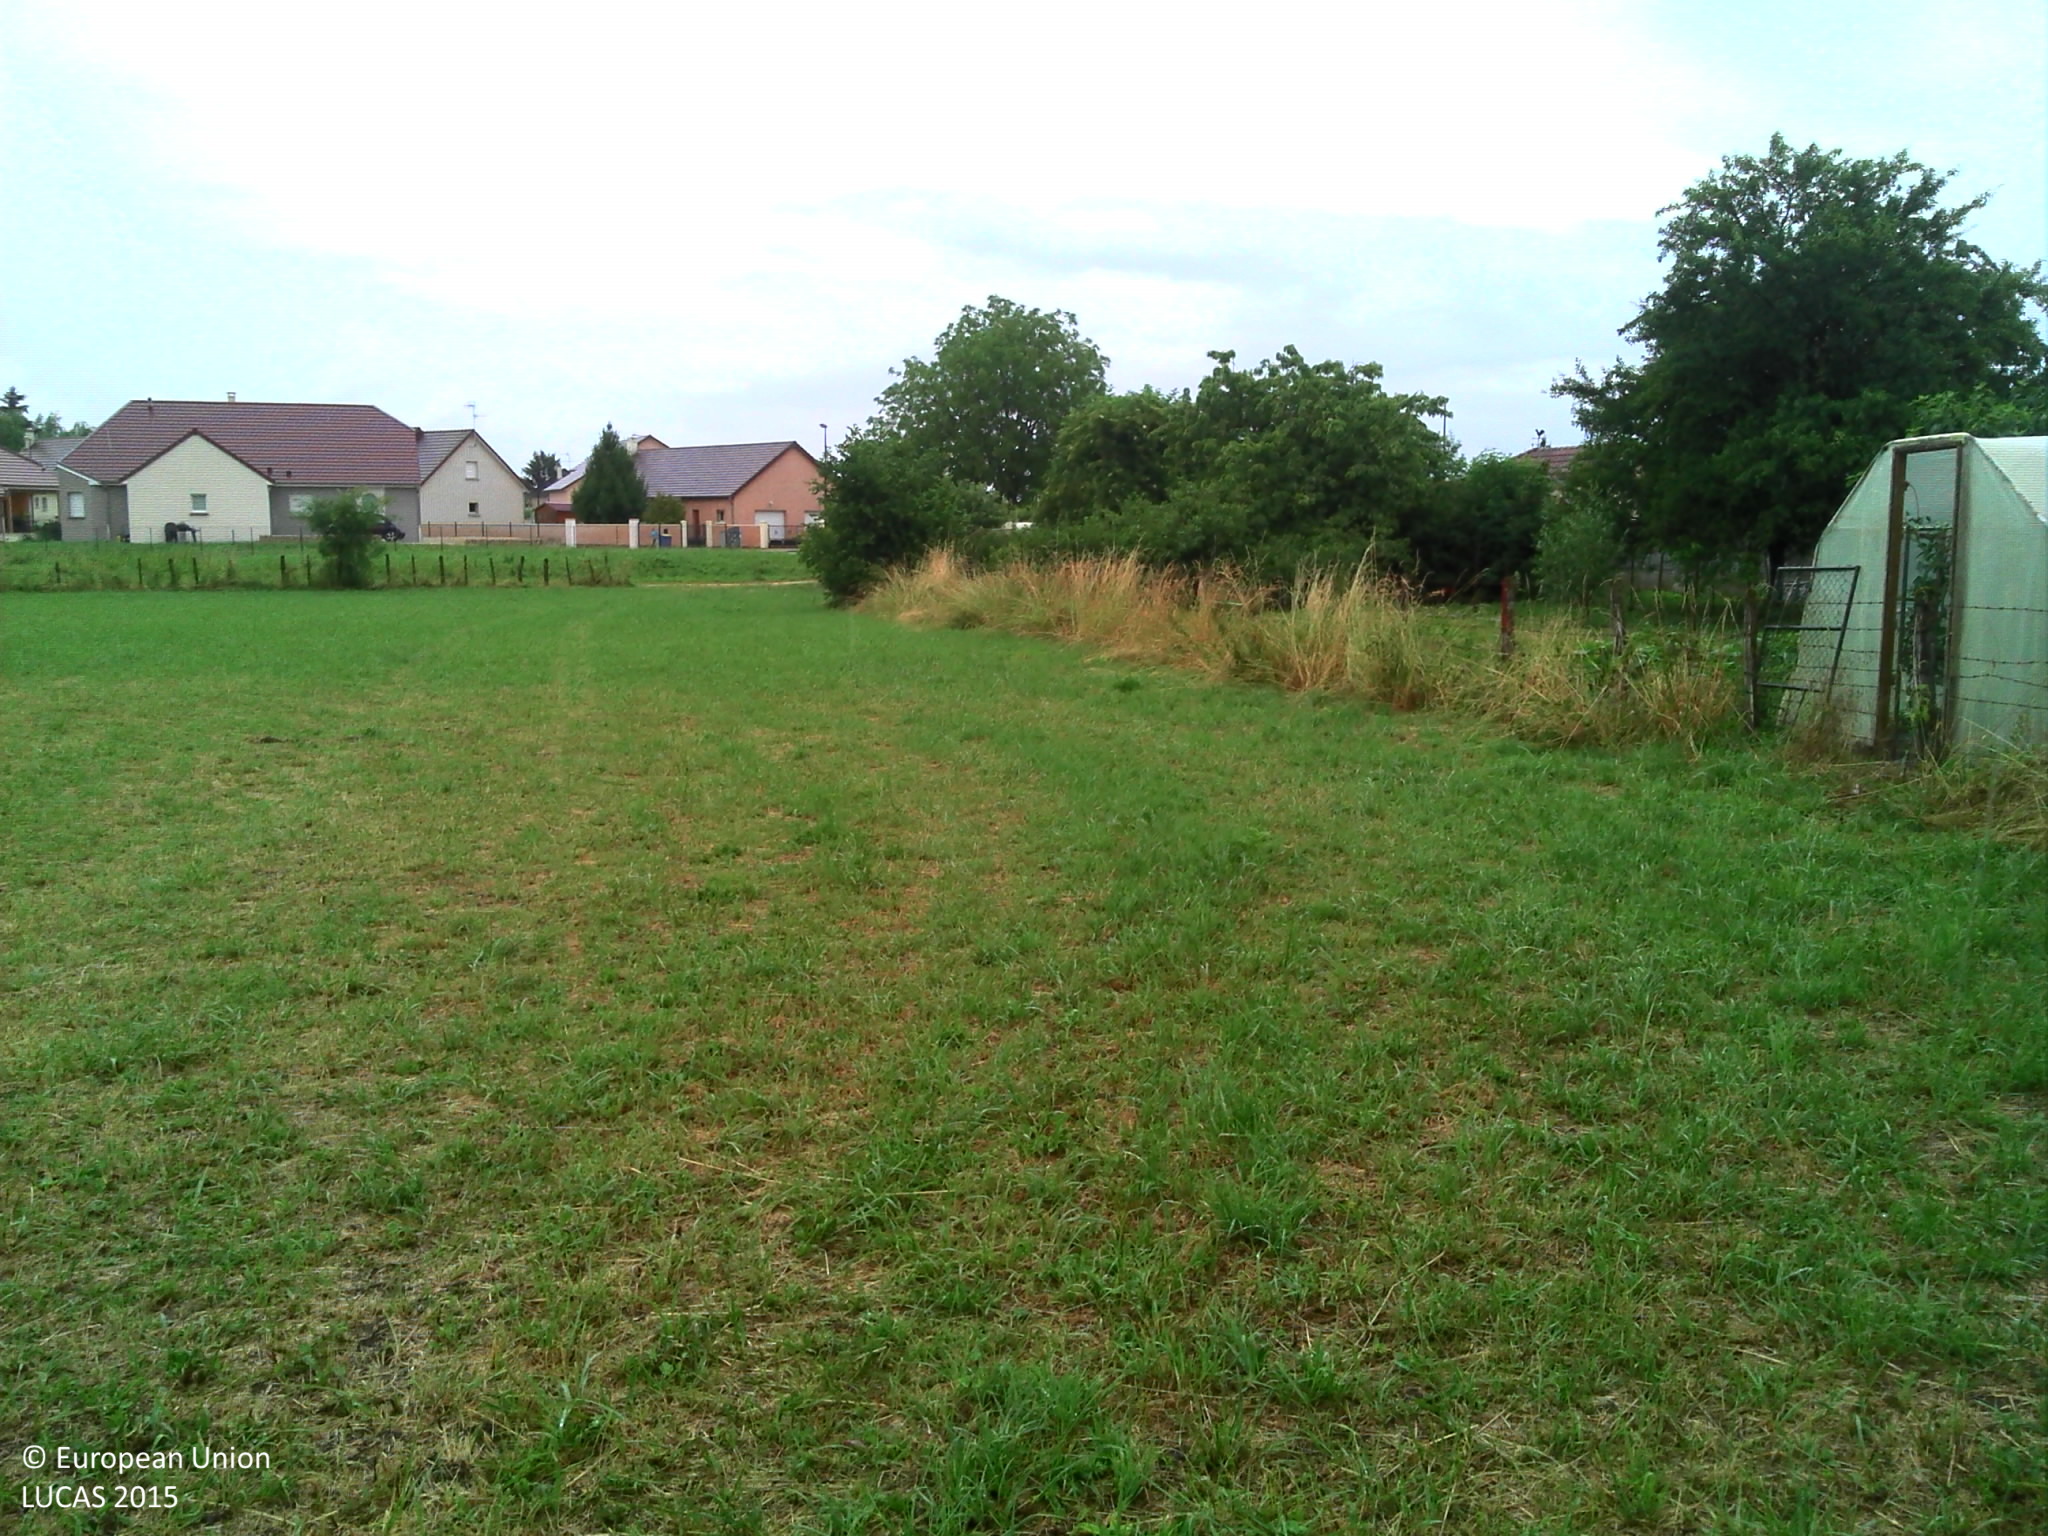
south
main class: Grassland
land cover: Grassland without tree/shrub cover
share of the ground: > 75 %
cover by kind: herbaceous plants 100 %
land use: Residential
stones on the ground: < 10 %
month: June
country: FR
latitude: 47.0092
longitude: 5.3847
